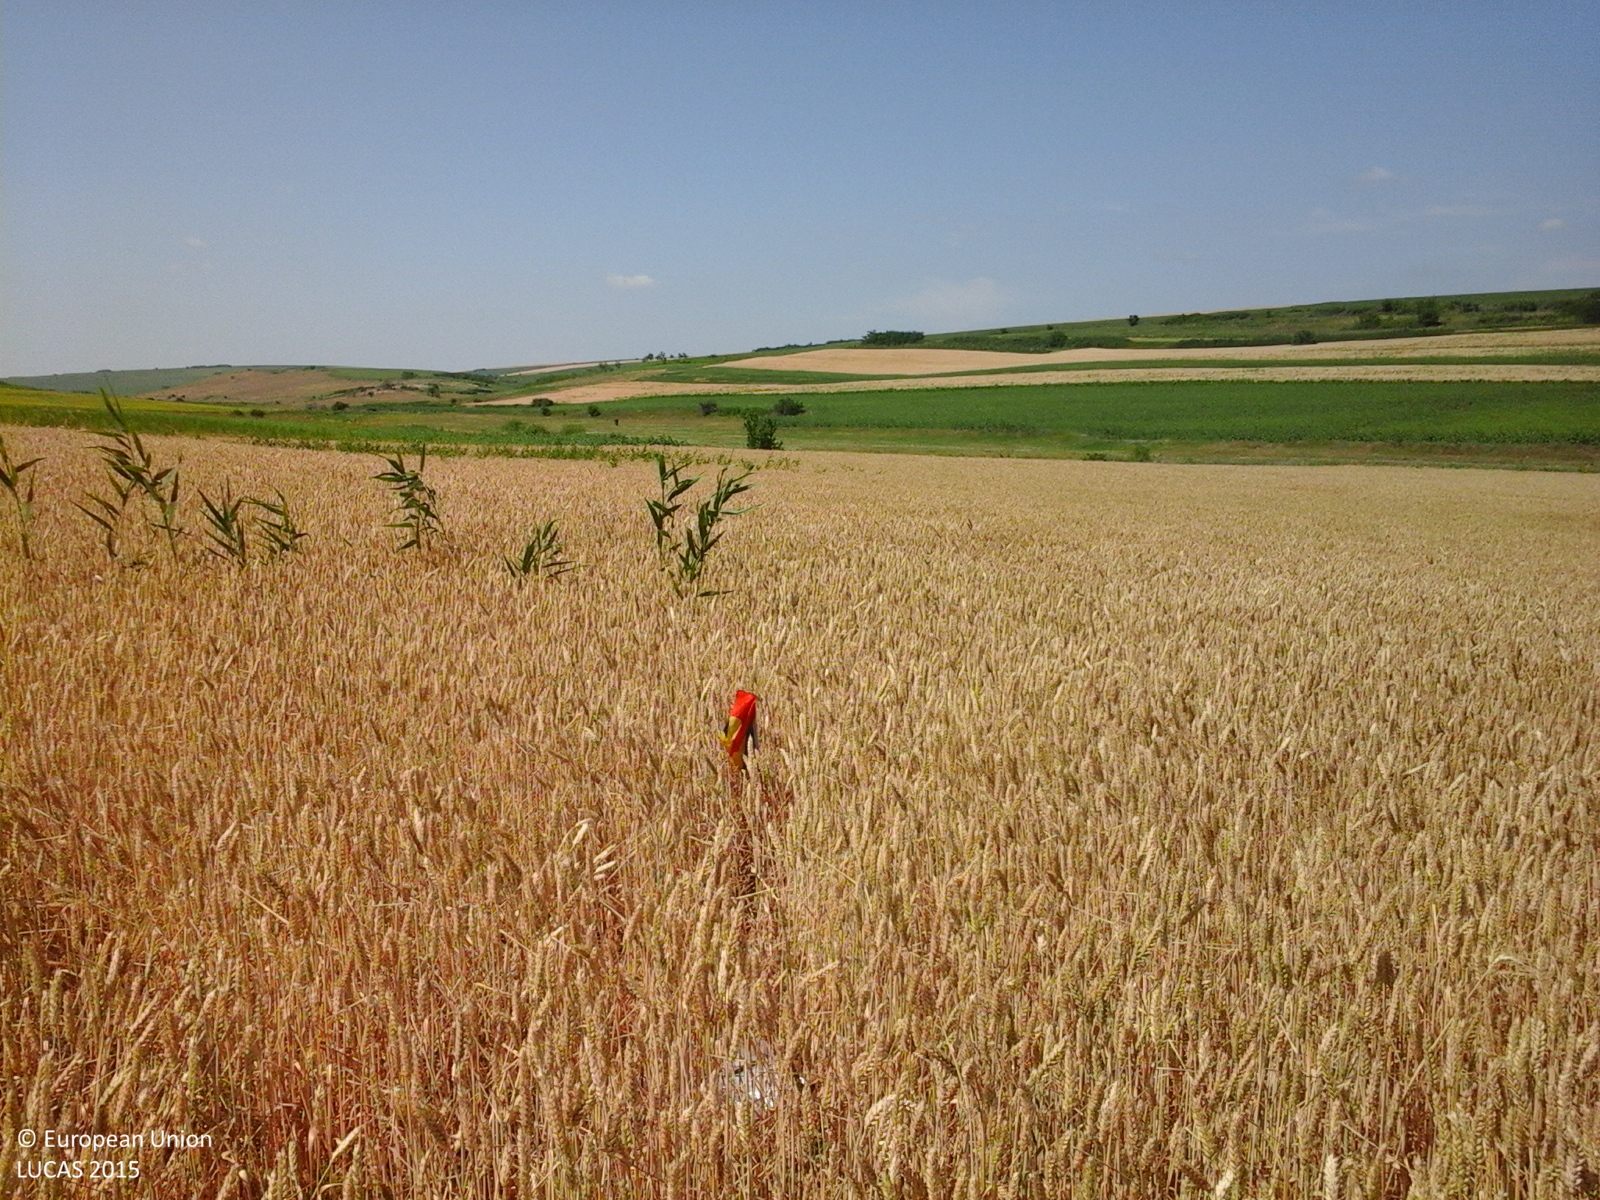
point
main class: Cropland
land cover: Common wheat
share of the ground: > 75 %
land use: Agriculture (excluding fallow land and kitchen gardens)
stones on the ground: < 10 %
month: June
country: RO
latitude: 46.8620
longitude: 28.0630
